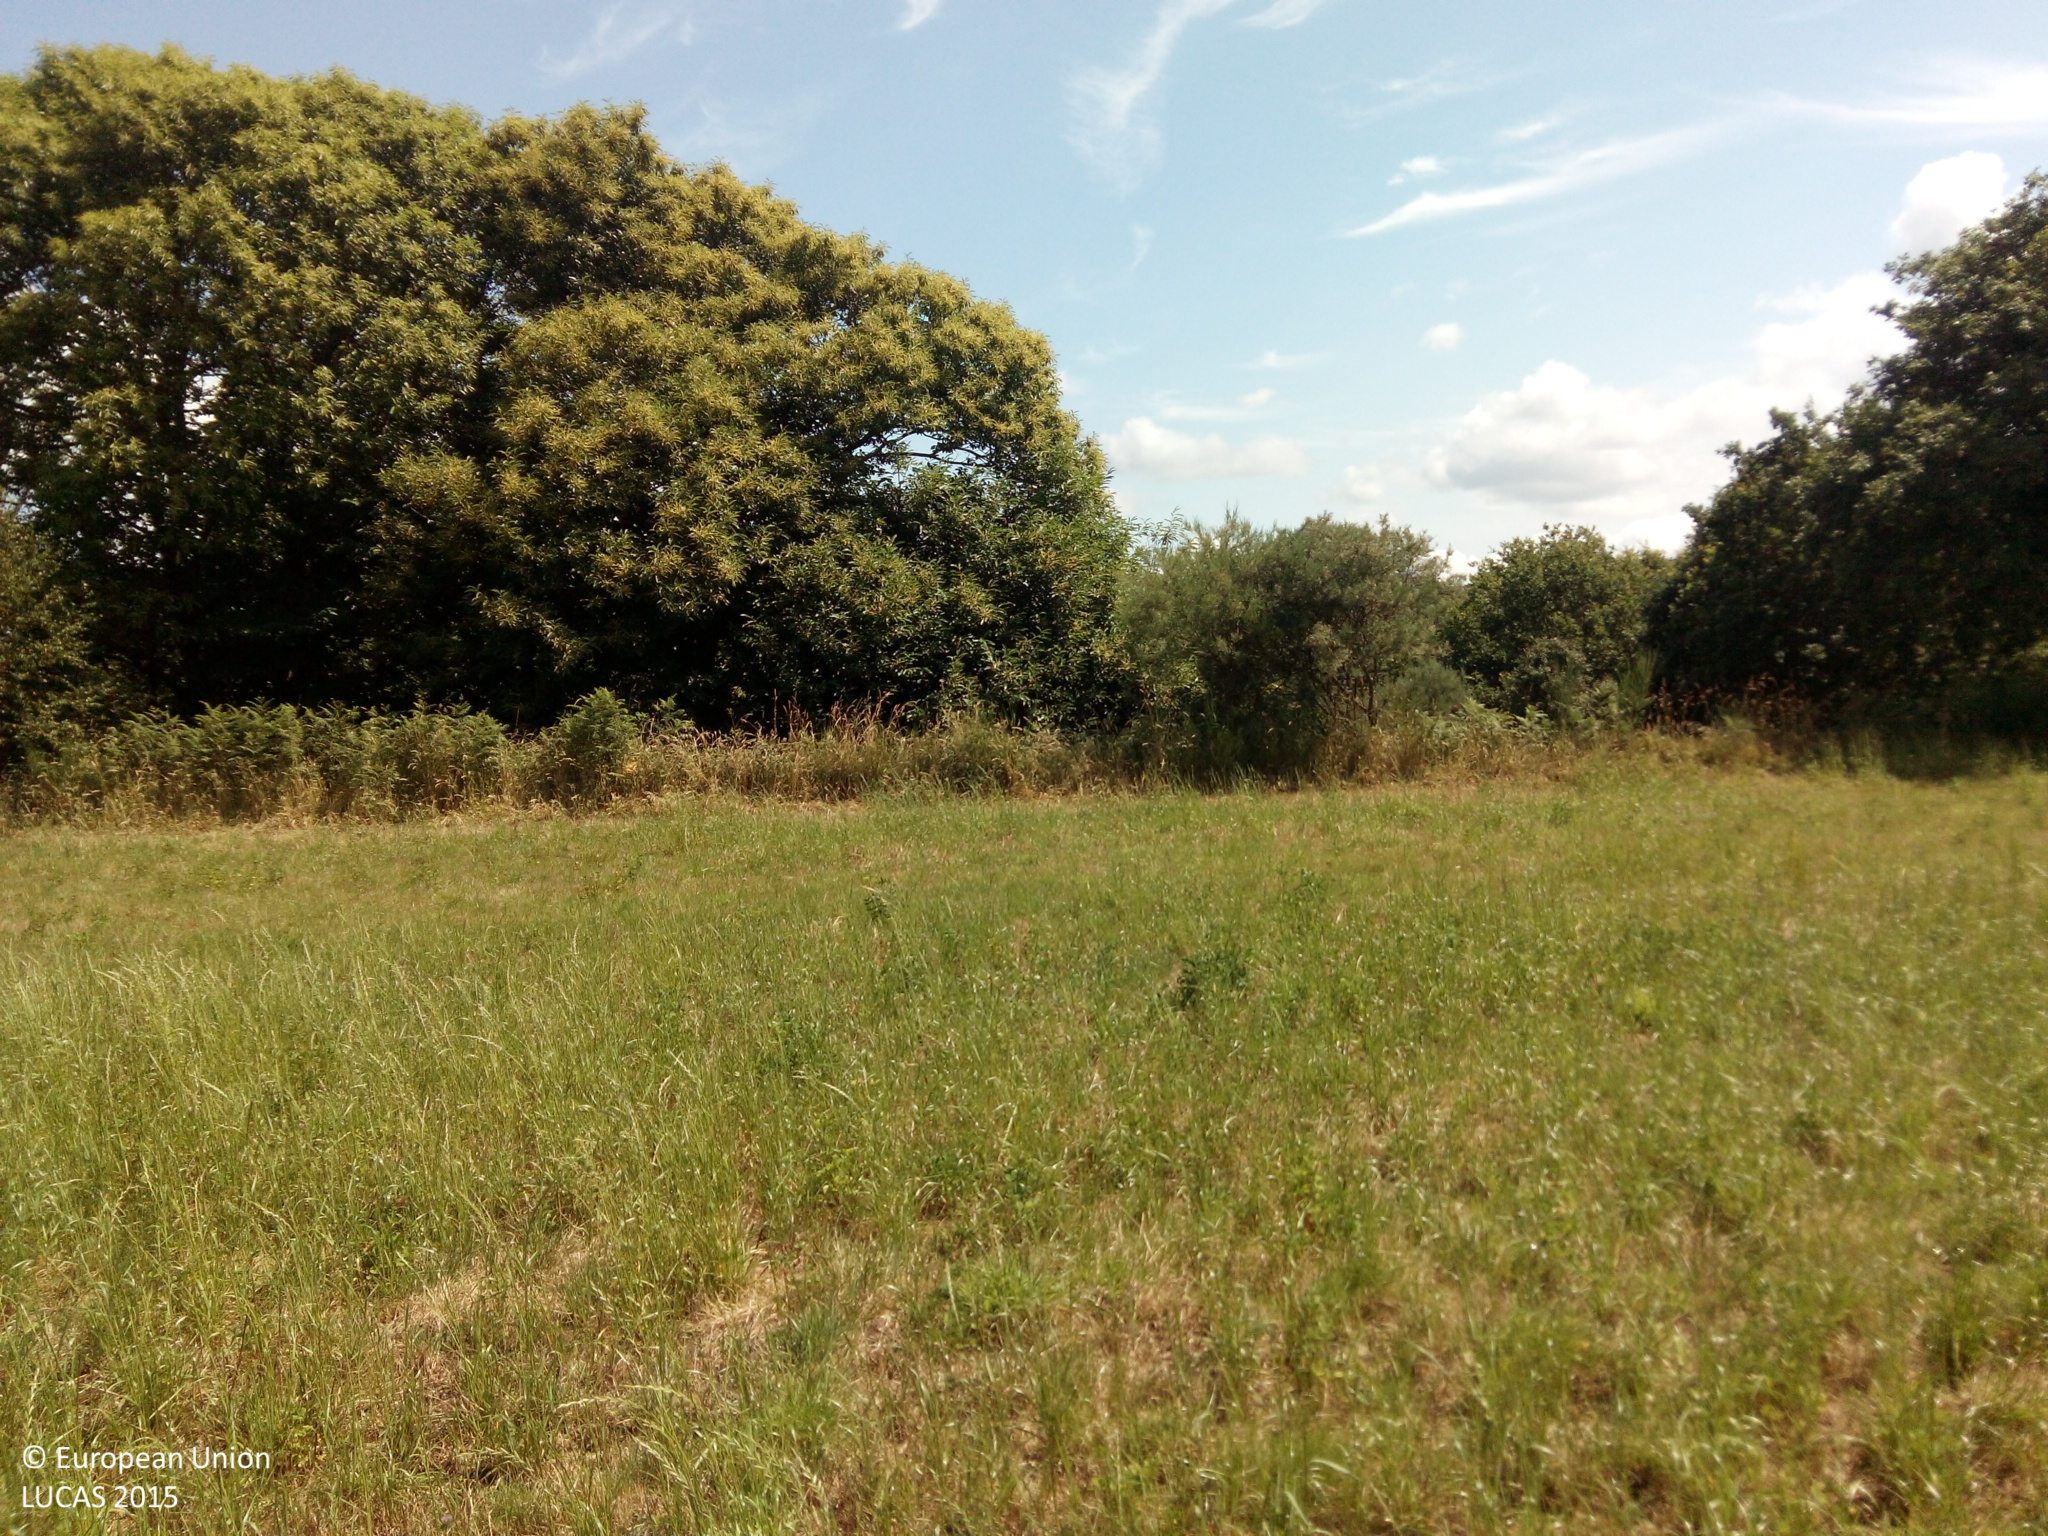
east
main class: Cropland
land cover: Temporary grasslands
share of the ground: 50 - 75 %
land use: Agriculture (excluding fallow land and kitchen gardens)
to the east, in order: Temporary grasslands; Lines of trees; Abandoned hedges; Tracks; Shrubland without tree cover; Shrubland with sparse tree cover; Electric lines; Tracks; Shrubland with sparse tree cover; Ditches and canals; Paved roads, cycling and walking lanes; Grass margins; Broadleaved woodland; Ditches and canals; Tracks; Broadleaved woodland
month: July
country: ES
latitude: 42.9894
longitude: -7.9580
